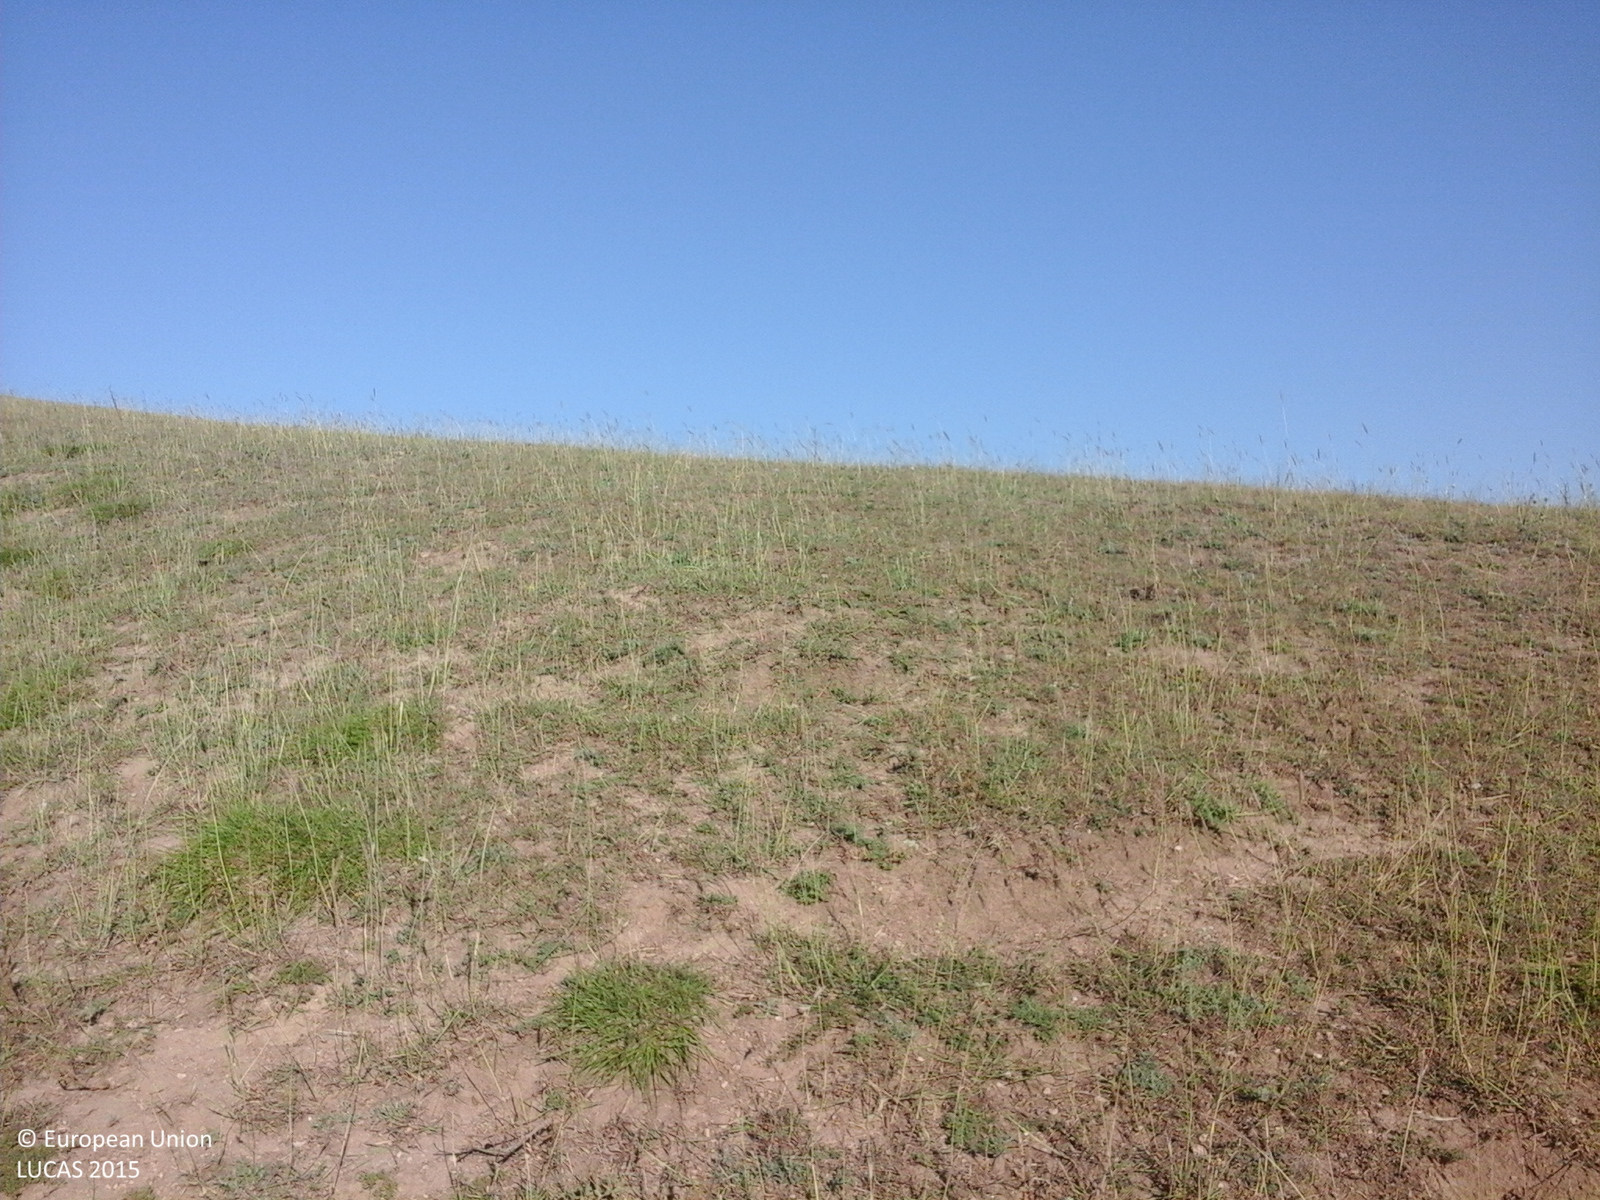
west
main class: Grassland
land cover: Grassland without tree/shrub cover
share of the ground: > 75 %
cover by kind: herbaceous plants 100 %
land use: Agriculture (excluding fallow land and kitchen gardens)
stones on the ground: > 50 %
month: August
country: RO
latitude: 44.4586
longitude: 28.5104
